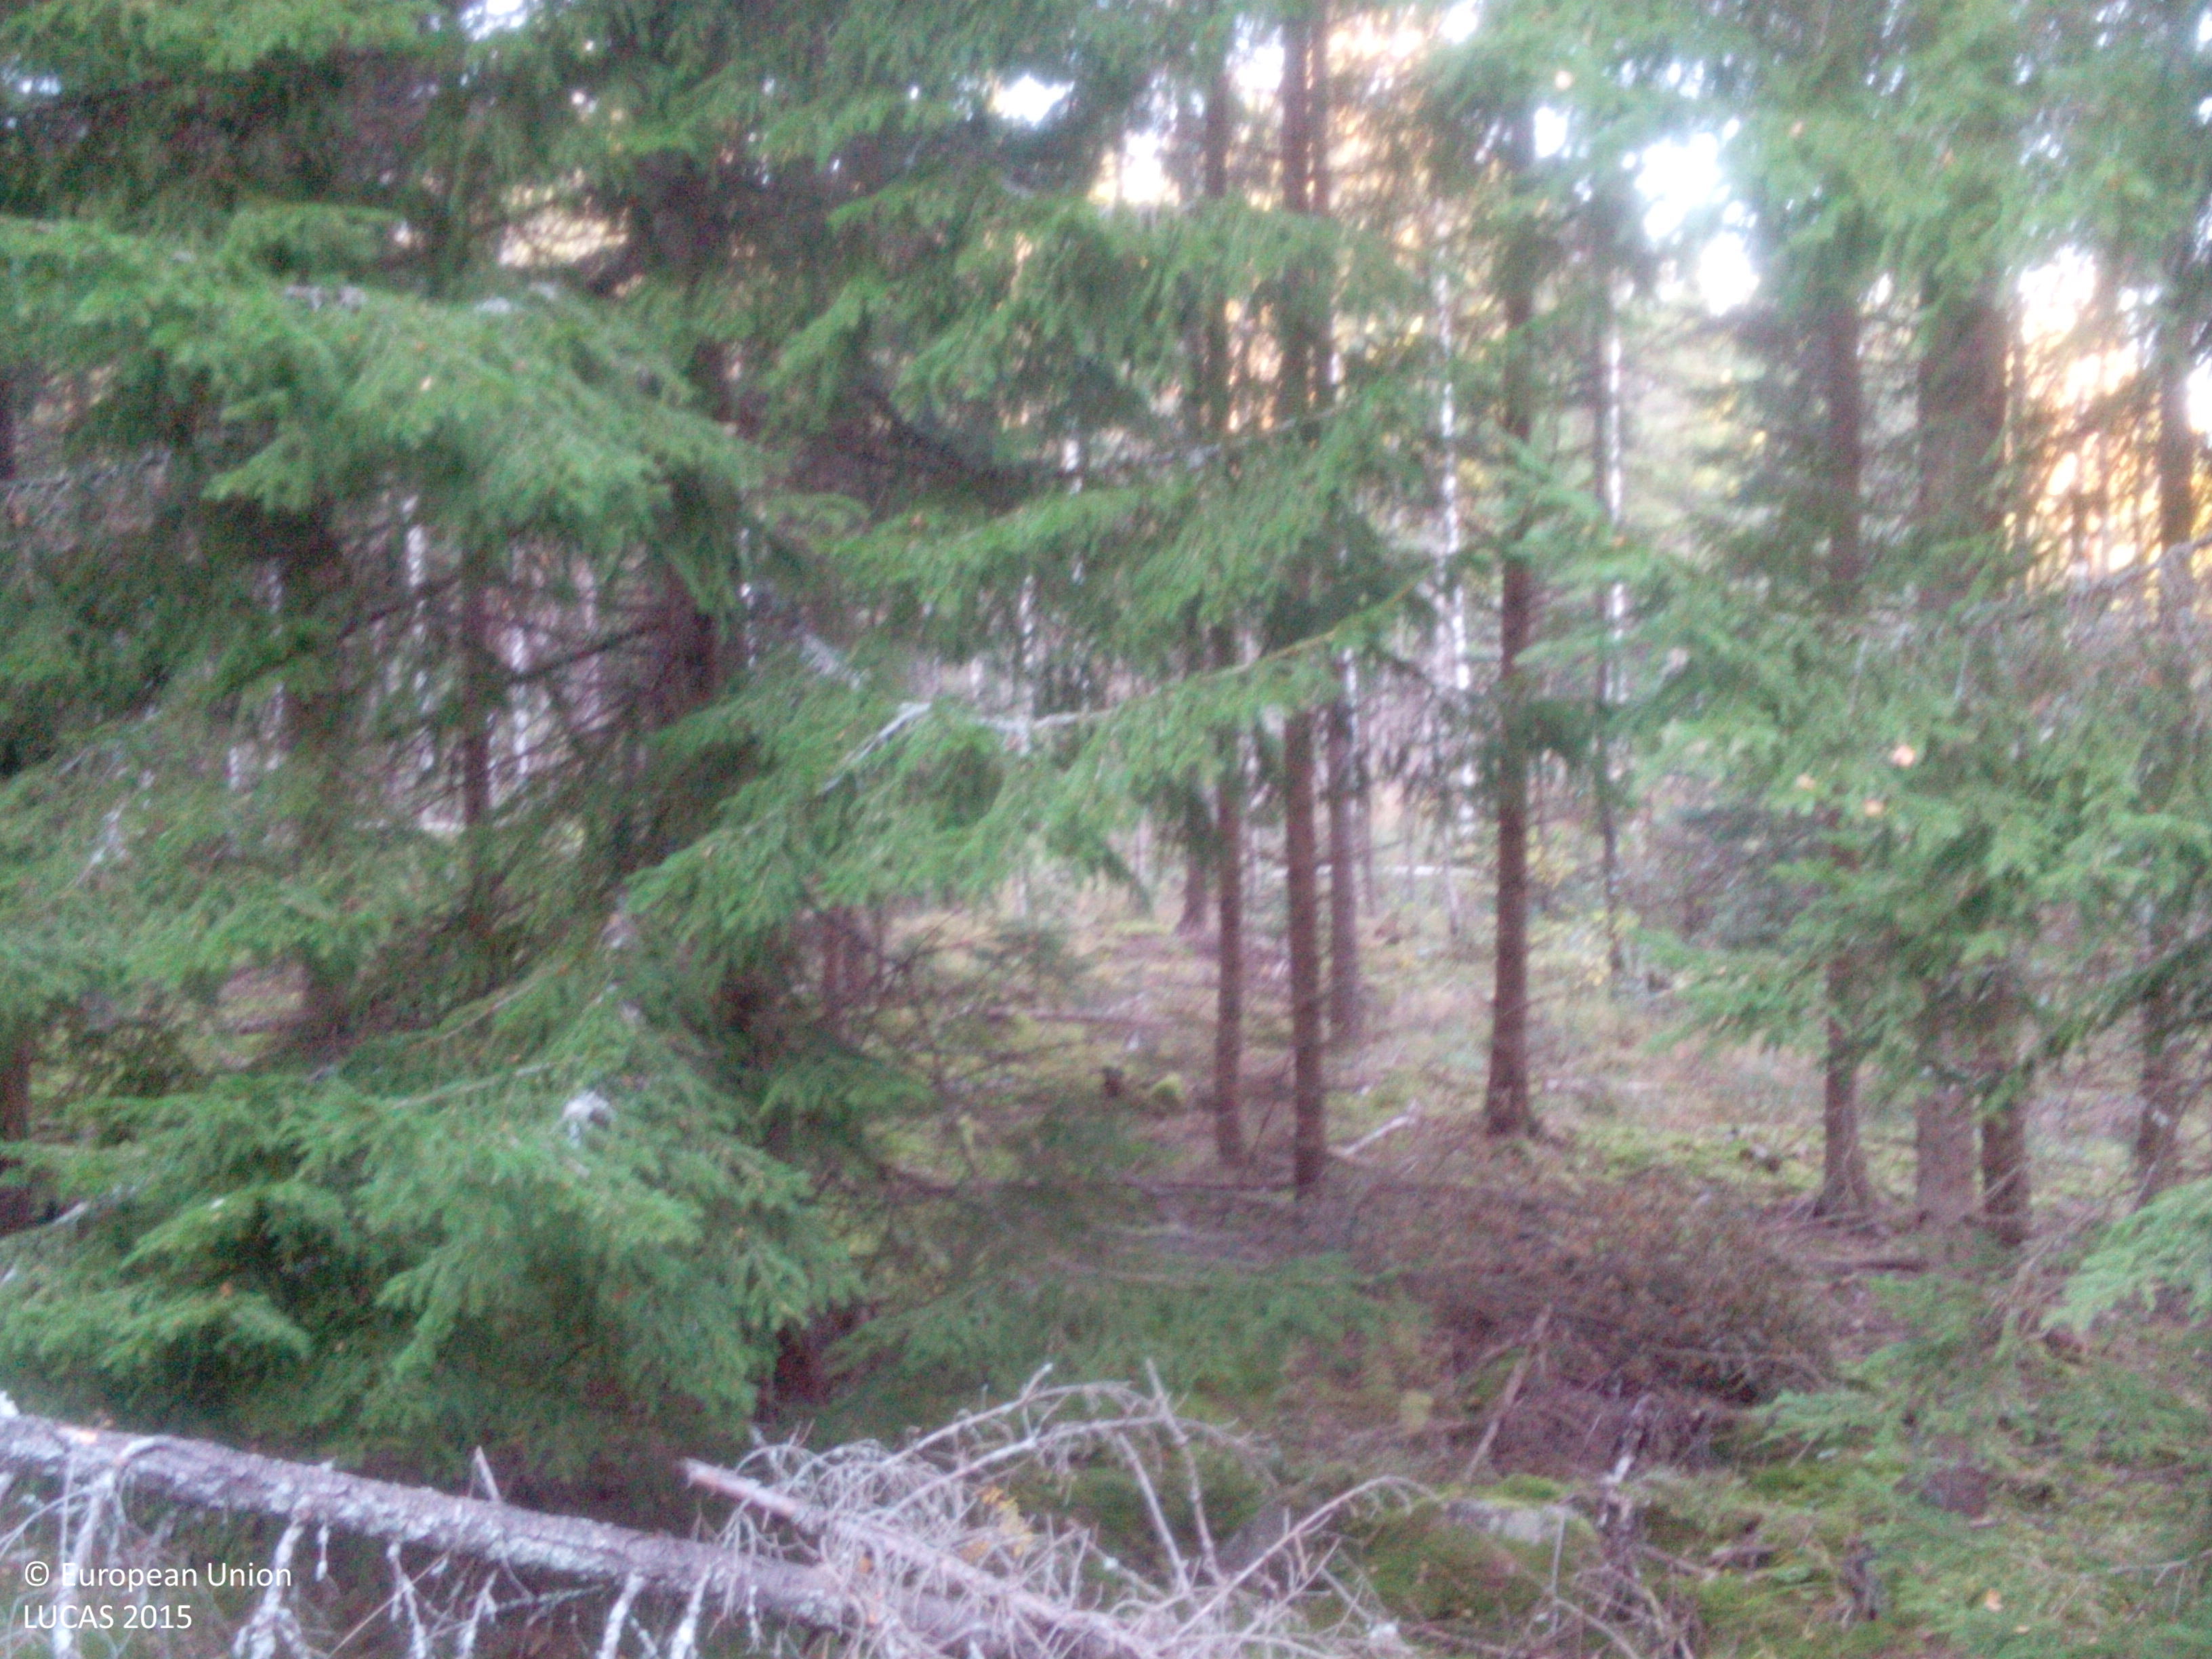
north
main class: Woodland
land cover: Spruce dominated coniferous woodland
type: boreal forest
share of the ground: 50 - 75 %
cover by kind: coniferous forest trees 50 %, herbaceous plants 35 %, broadleaved forest trees 10 %, lichens and mosses 5 %
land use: Forestry
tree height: > 5 m
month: October
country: SE
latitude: 58.8455
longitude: 16.3546
